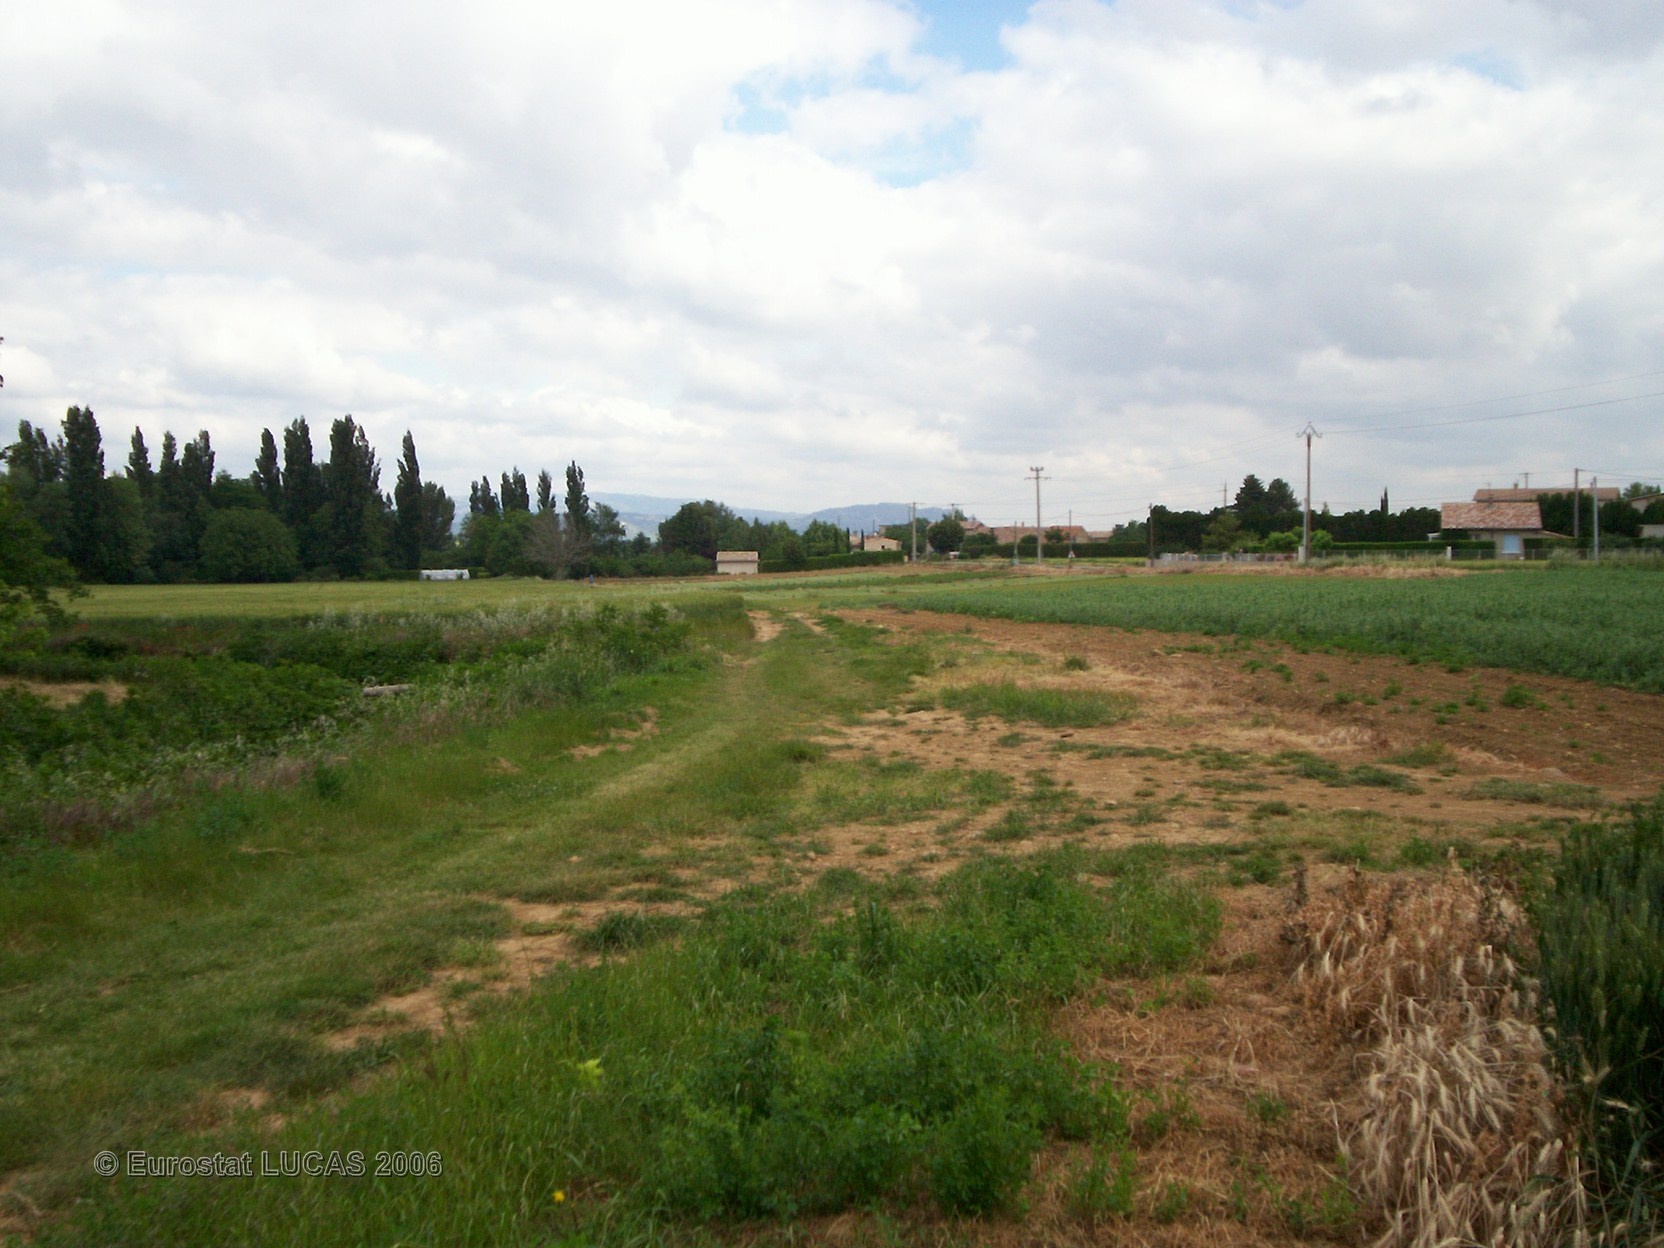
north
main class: Grassland
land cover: Grassland without tree/shrub cover
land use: Agriculture (excluding fallow land and kitchen gardens)
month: June
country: FR
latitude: 44.8206
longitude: 4.8842
